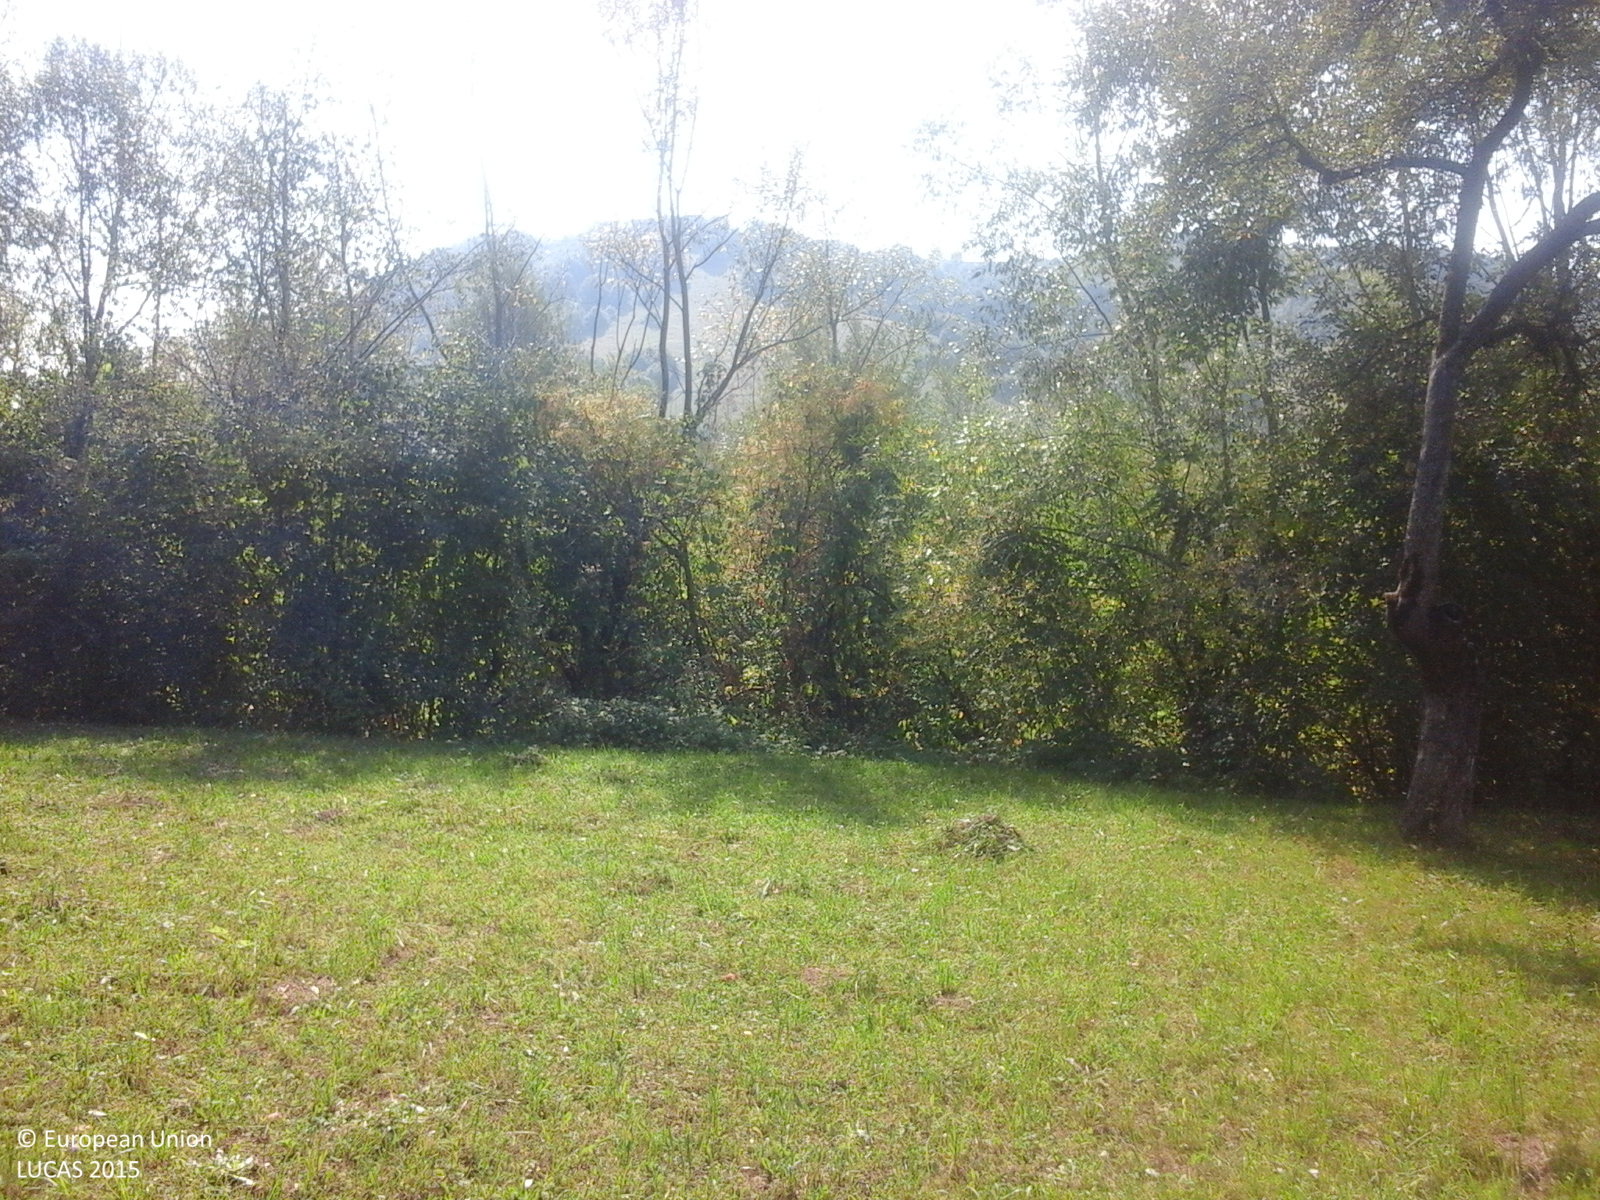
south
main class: Grassland
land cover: Grassland without tree/shrub cover
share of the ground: > 75 %
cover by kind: herbaceous plants 100 %
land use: Agriculture (excluding fallow land and kitchen gardens)
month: September
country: RO
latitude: 47.7814
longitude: 24.2779
